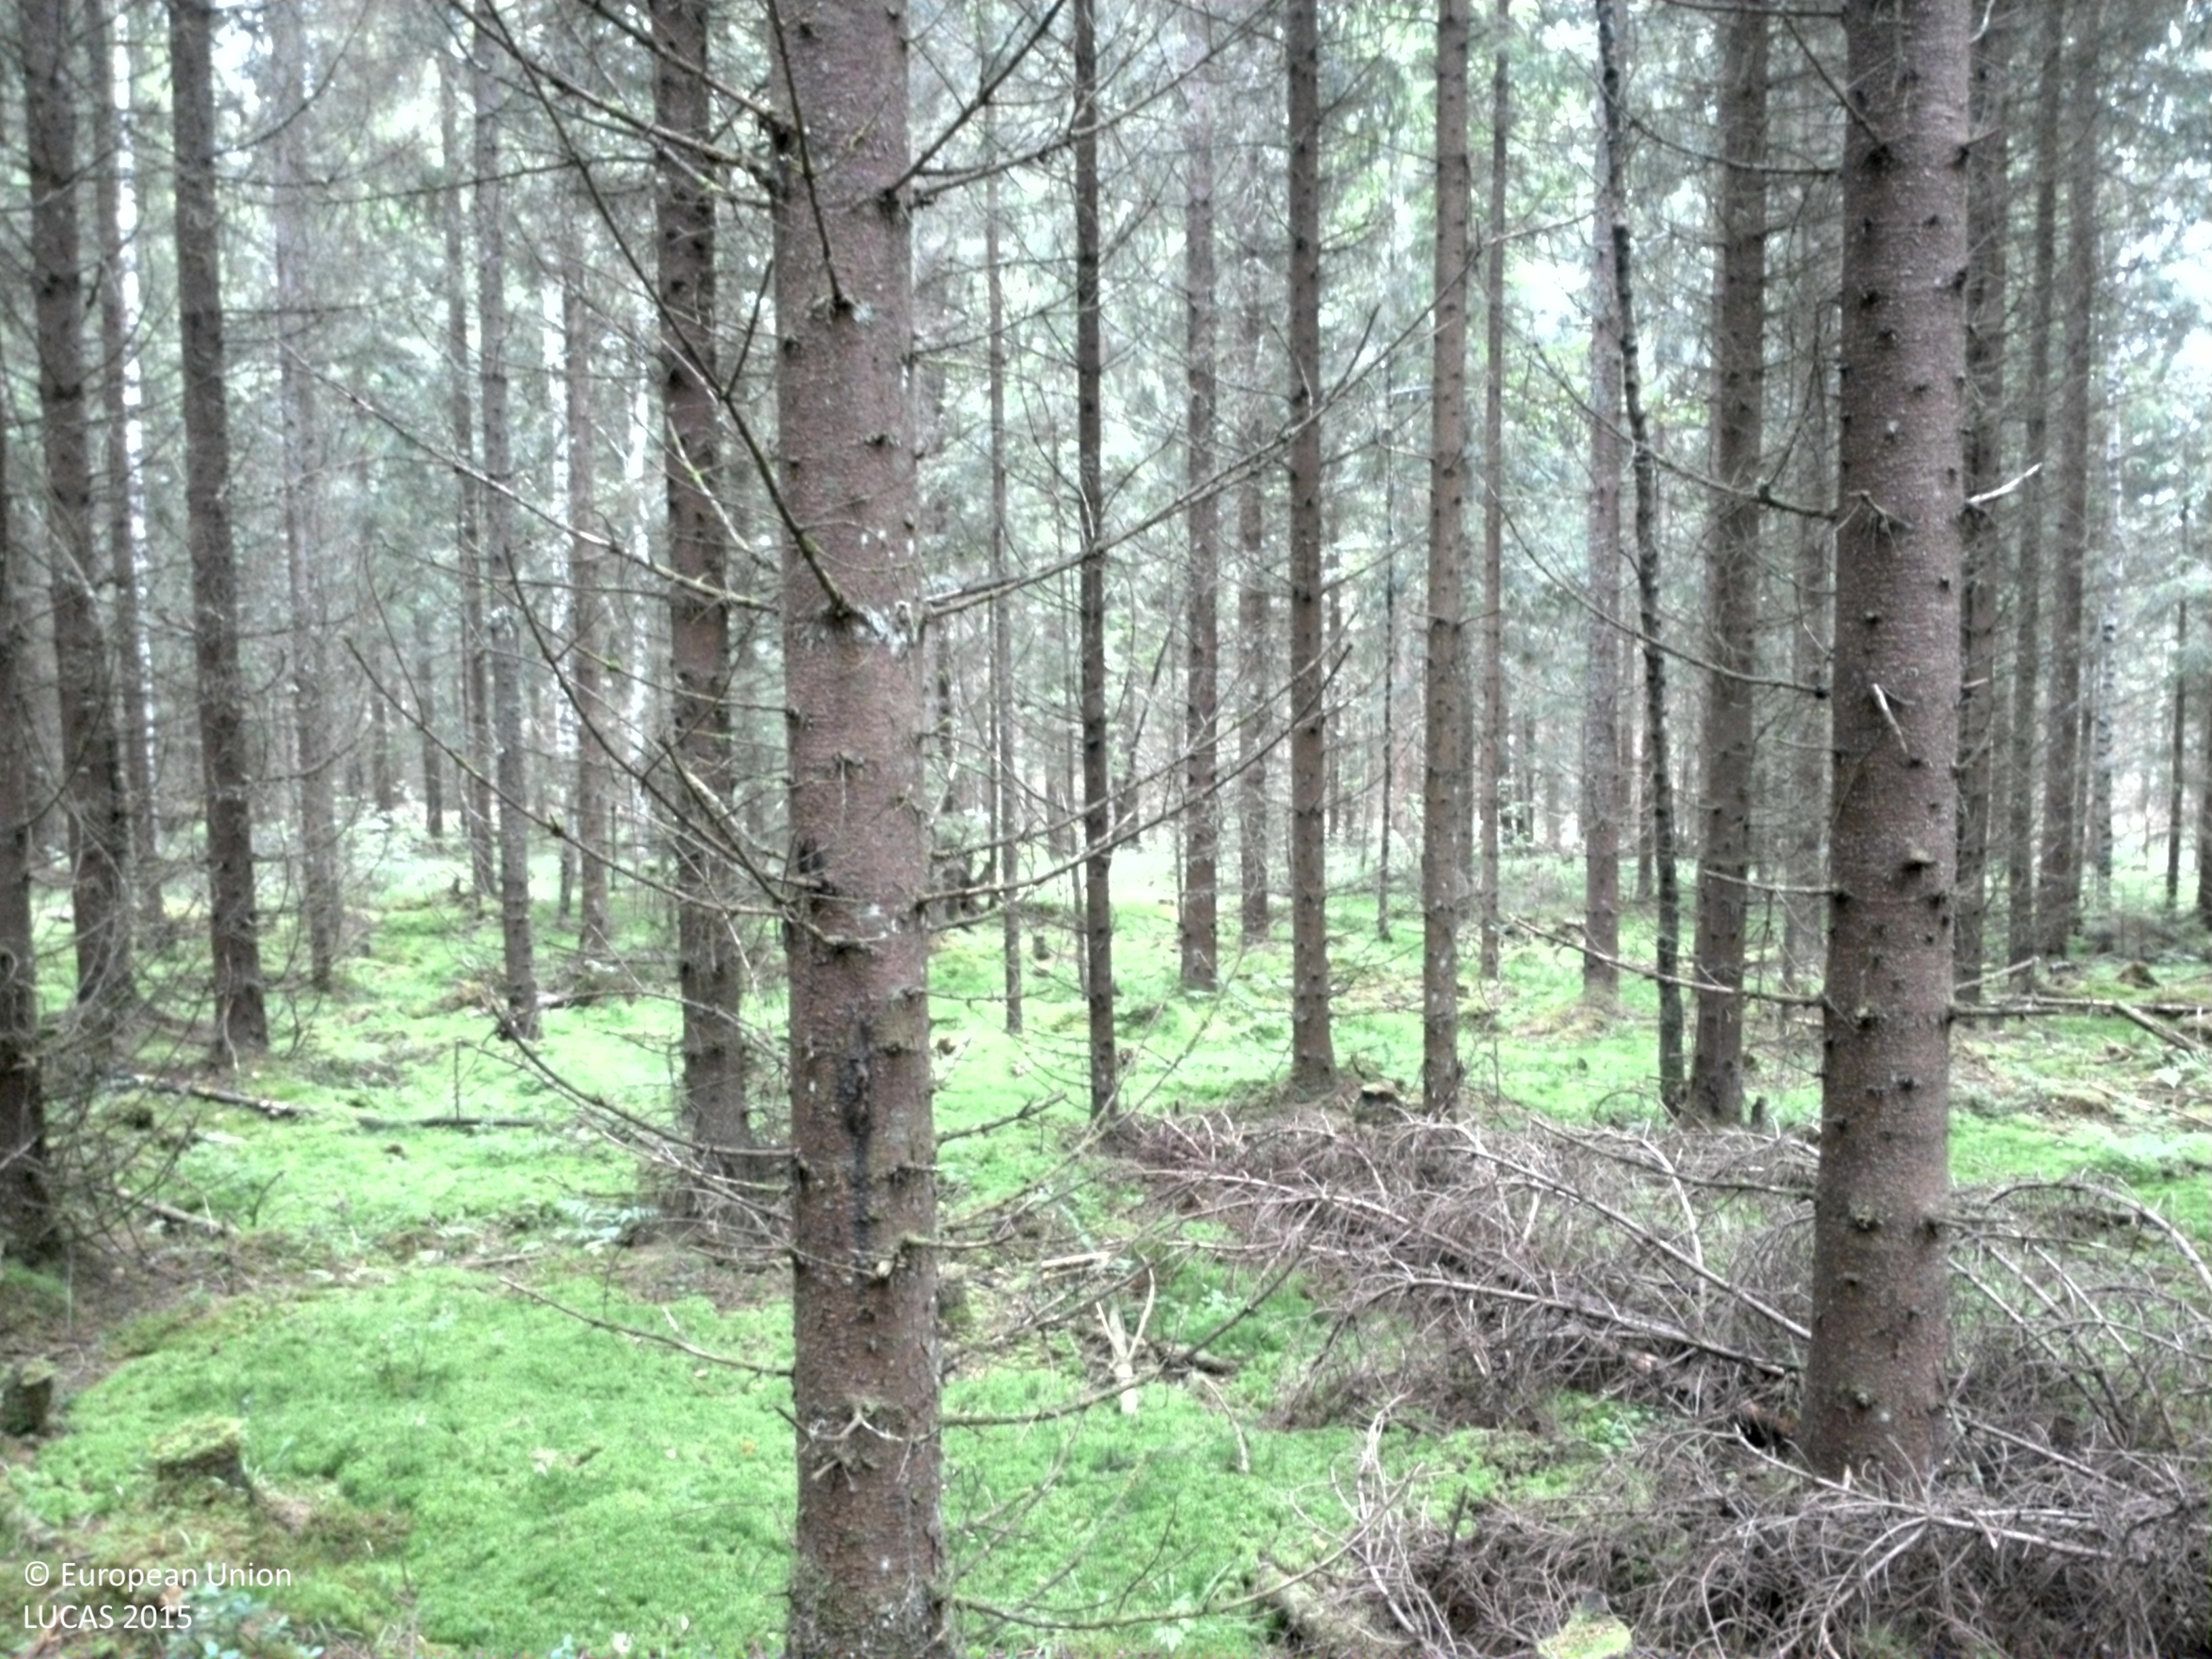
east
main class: Woodland
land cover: Spruce dominated coniferous woodland
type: boreal forest
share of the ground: 50 - 75 %
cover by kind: coniferous forest trees 65 %, lichens and mosses 20 %, broadleaved forest trees 5 %, shrubs 5 %, herbaceous plants 5 %
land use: Forestry
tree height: > 5 m
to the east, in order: Spruce dominated coniferous woodland; Tracks; Spruce dominated coniferous woodland; Rivers and streams; Spruce dominated coniferous woodland; Shrubland without tree cover; Electric lines; Shrubland without tree cover; Spruce dominated coniferous woodland; Tracks; Spruce dominated coniferous woodland
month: August
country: SE
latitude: 59.6219
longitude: 13.2009
